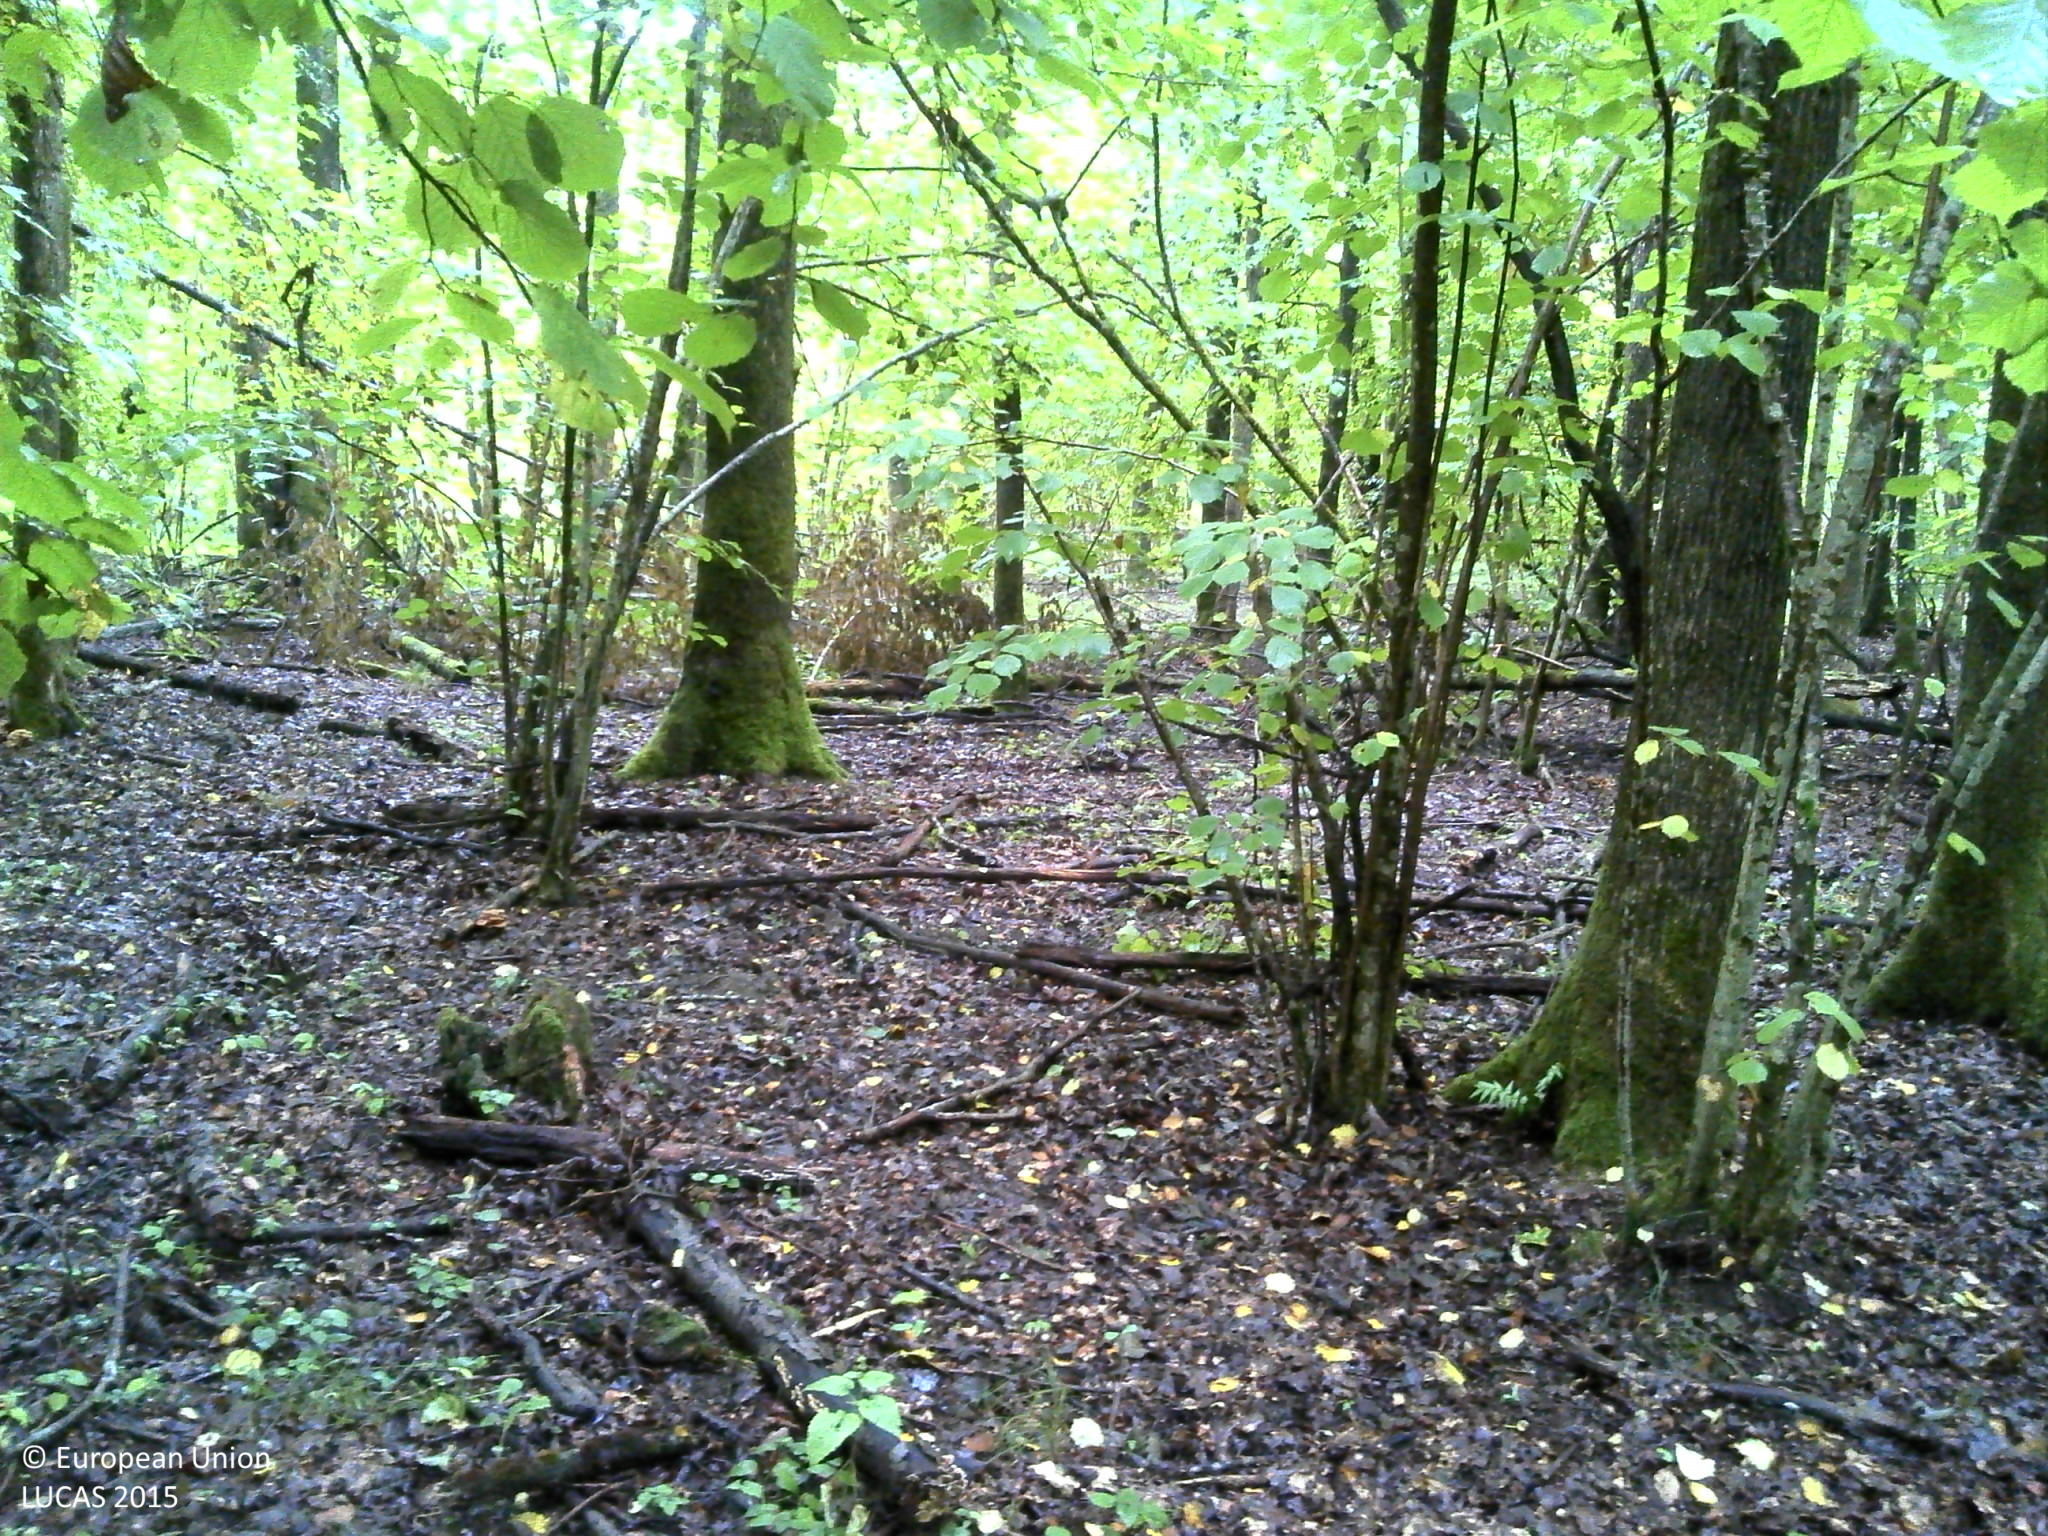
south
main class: Woodland
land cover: Broadleaved woodland
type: mesophytic deciduous forest
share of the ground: > 75 %
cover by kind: broadleaved forest trees 100 %
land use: Forestry
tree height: > 5 m
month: August
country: HR
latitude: 45.5700
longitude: 15.6474
